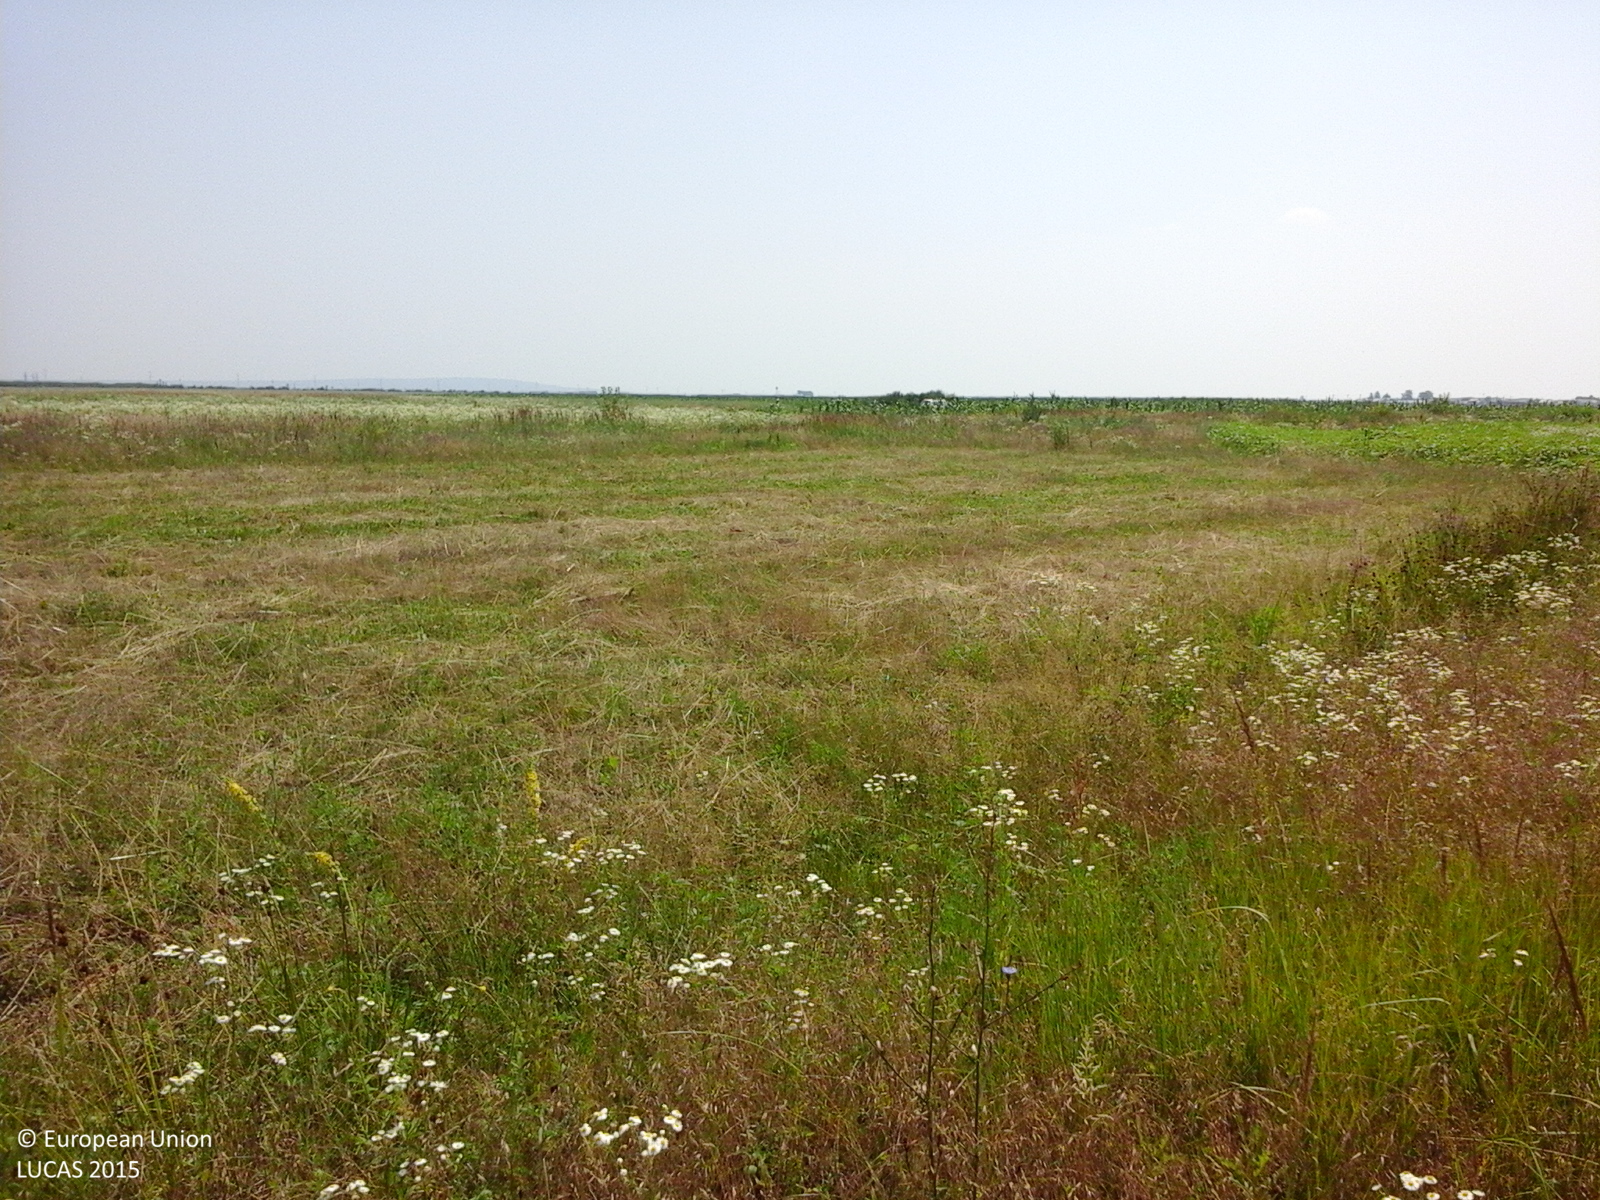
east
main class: Grassland
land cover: Grassland without tree/shrub cover
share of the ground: > 75 %
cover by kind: herbaceous plants 100 %
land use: Agriculture (excluding fallow land and kitchen gardens)
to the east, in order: Grassland without tree/shrub cover; Tracks; Common wheat; Oats; Grassland without tree/shrub cover
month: July
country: RO
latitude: 44.8685
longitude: 25.4729
